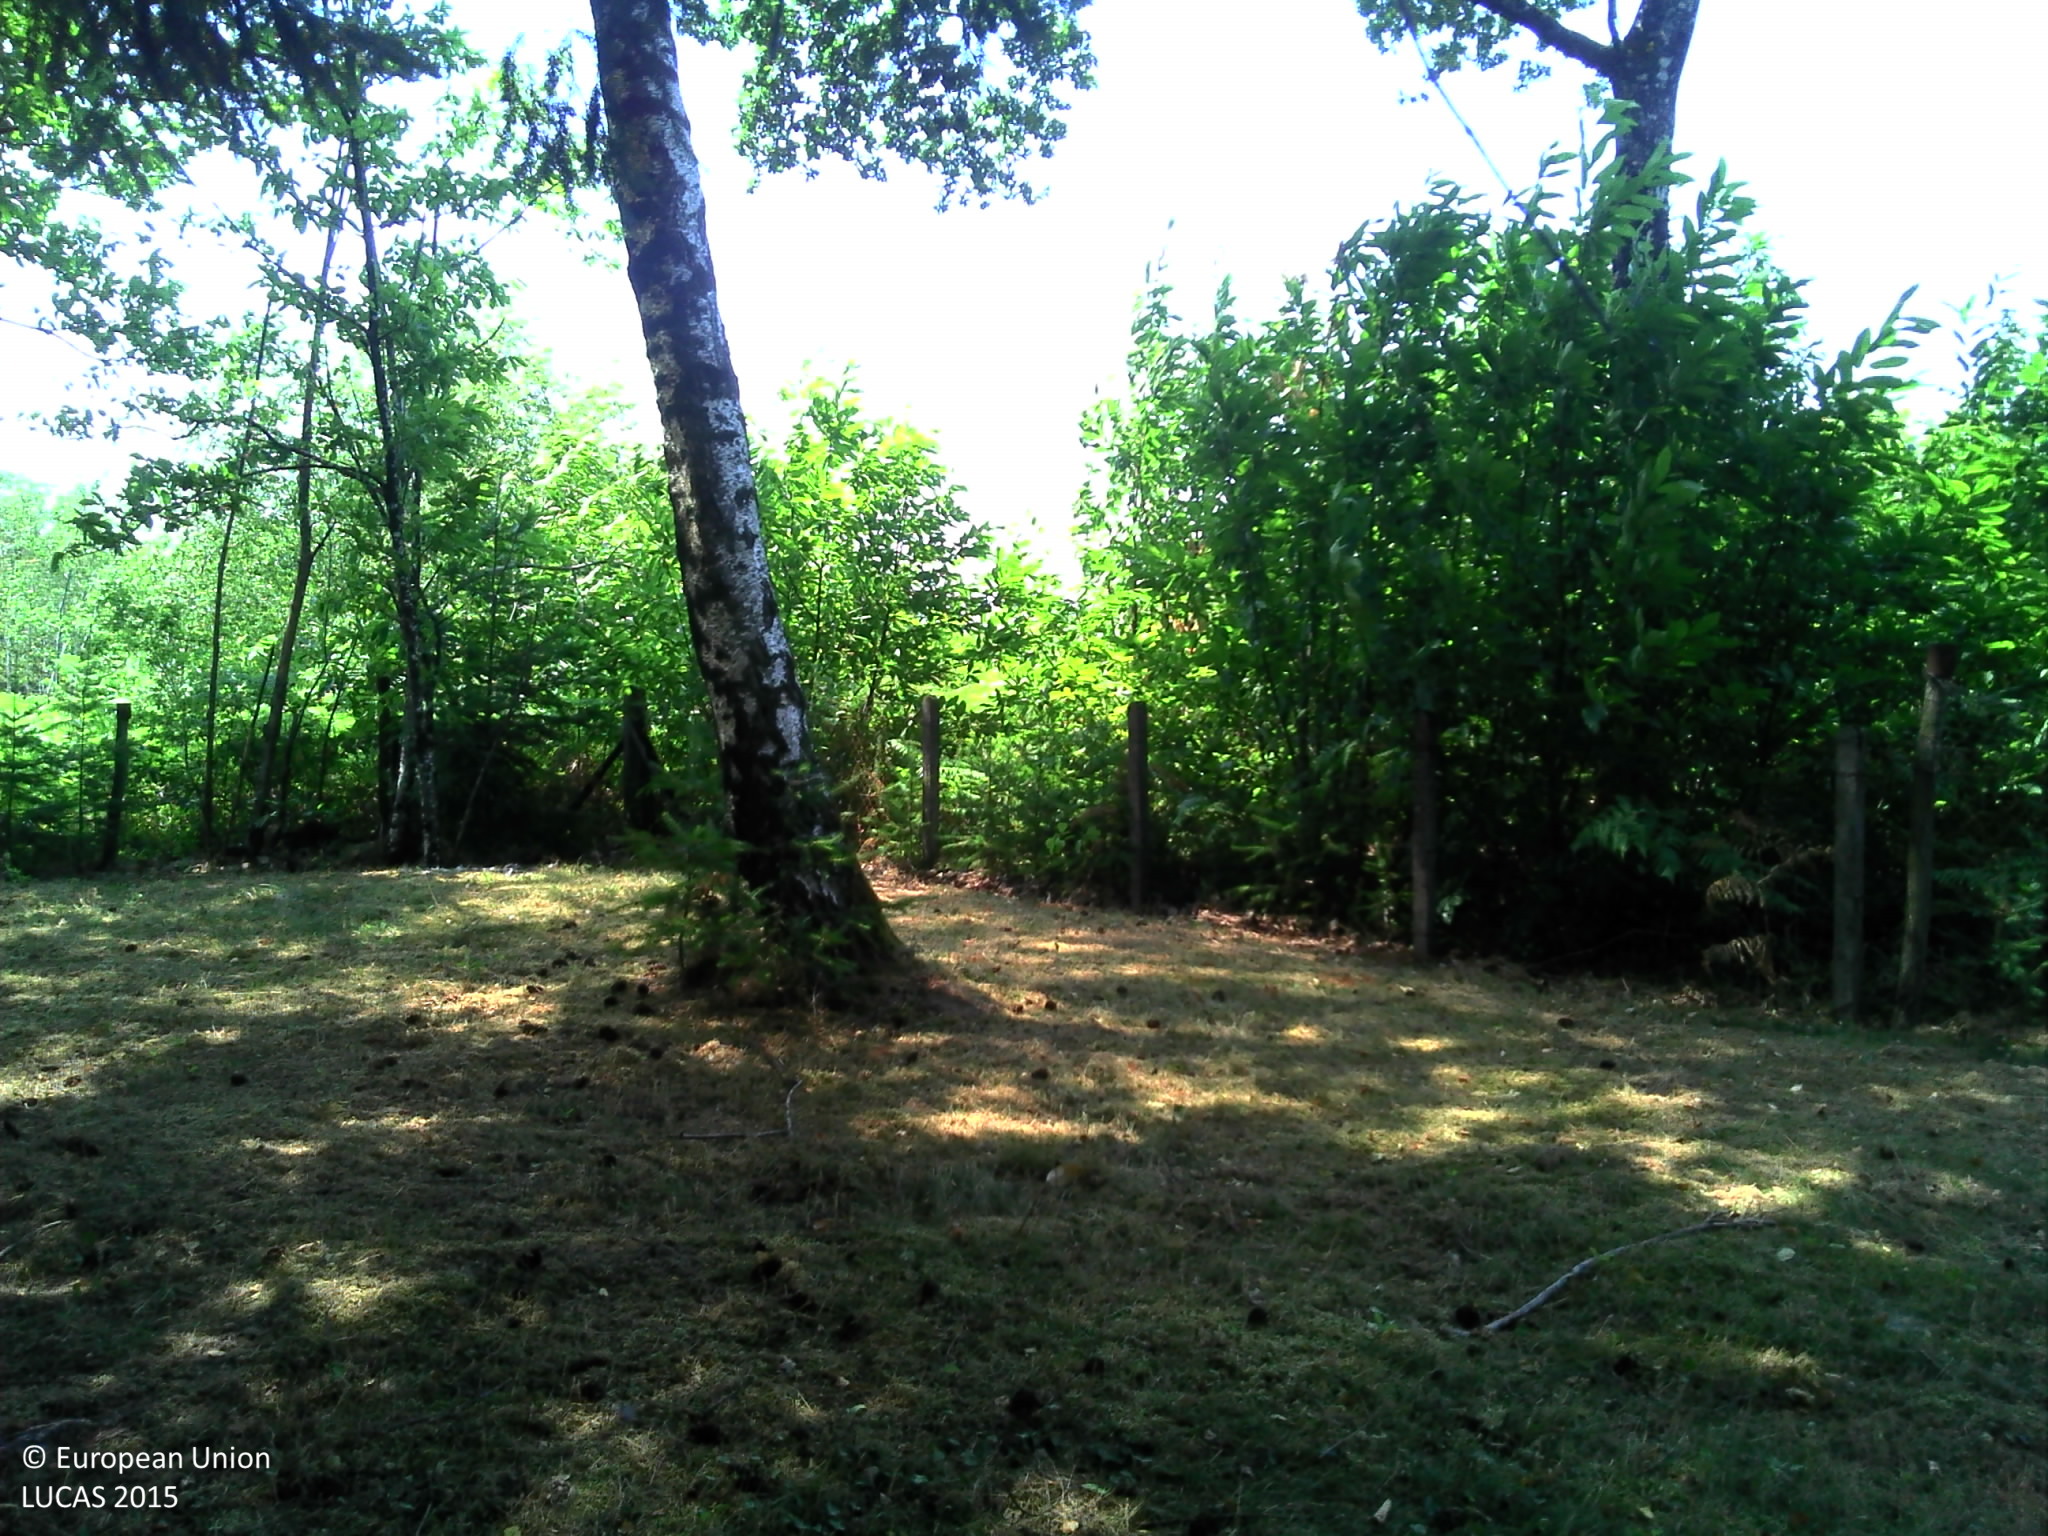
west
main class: Woodland
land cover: Other mixed woodland
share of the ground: > 75 %
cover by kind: broadleaved forest trees 55 %, coniferous forest trees 25 %, herbaceous plants 20 %
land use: Residential
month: July
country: FR
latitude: 45.6110
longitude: 1.0271
